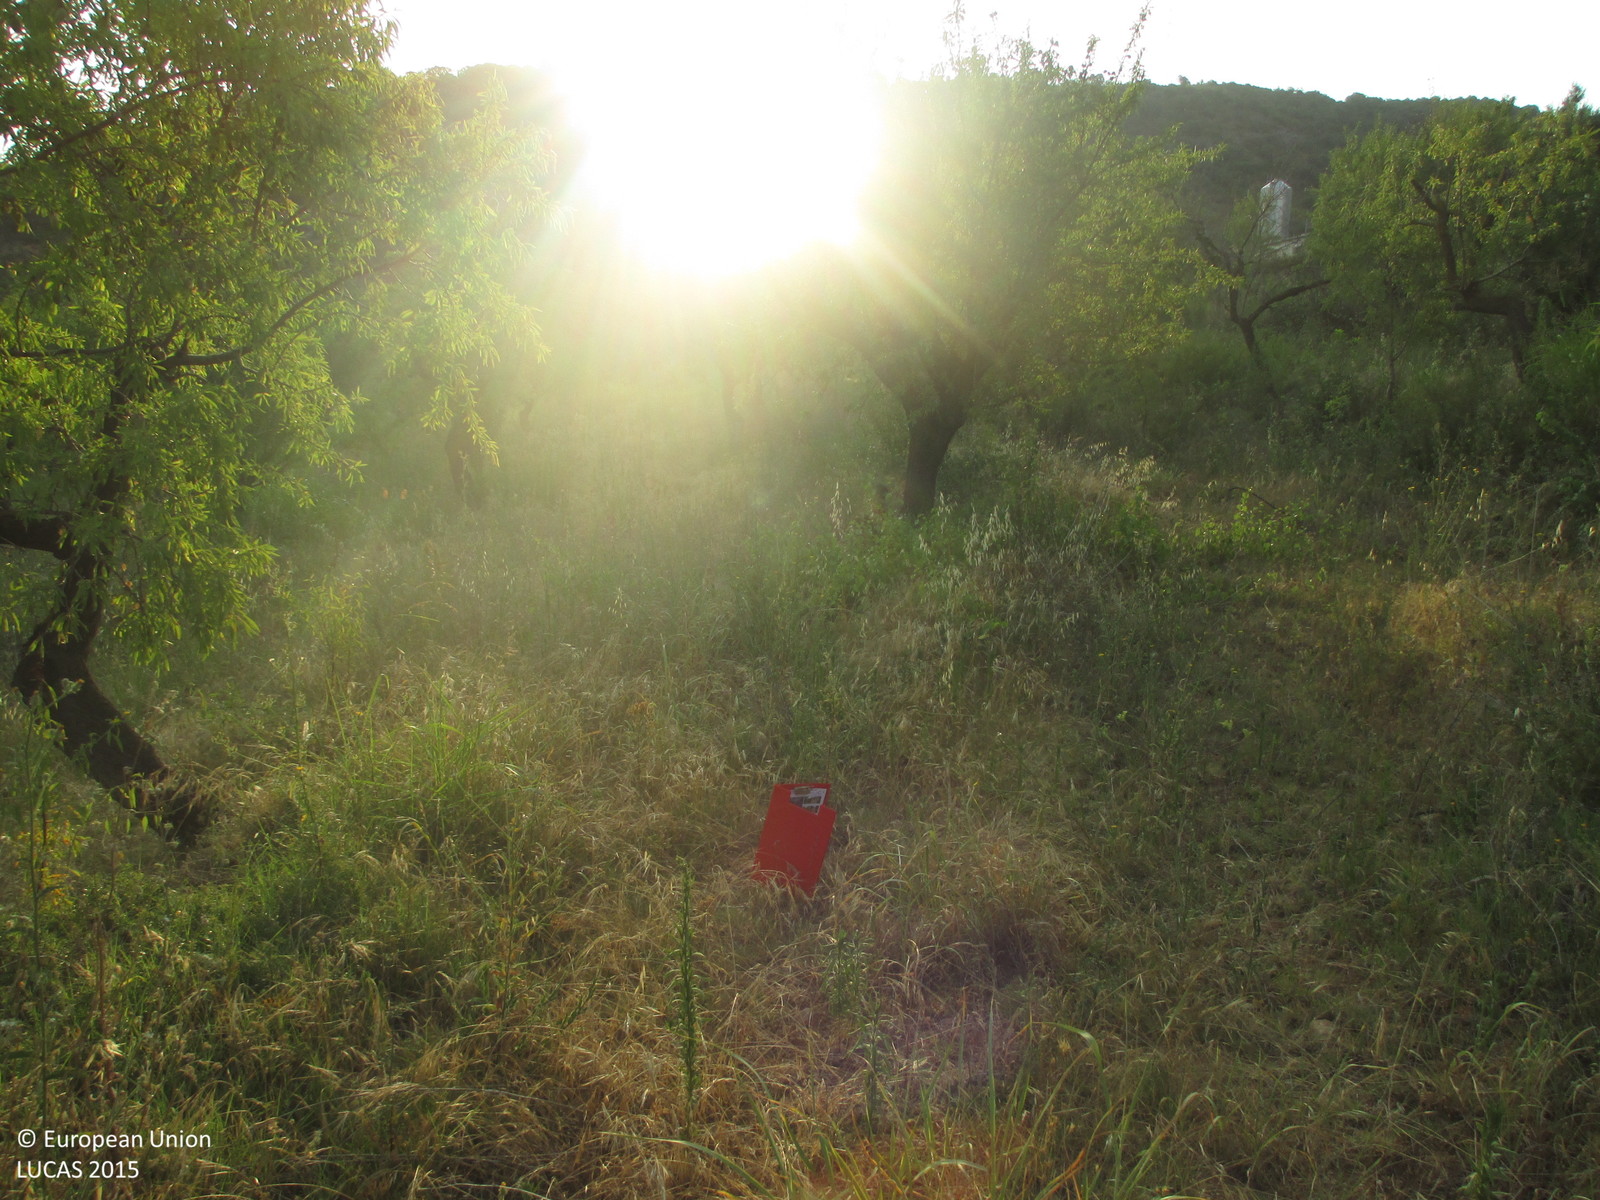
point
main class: Cropland
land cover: Nuts trees
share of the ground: 50 - 75 %
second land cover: Spontaneously vegetated surfaces
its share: > 75 %
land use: Agriculture (excluding fallow land and kitchen gardens)
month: July
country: ES
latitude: 42.1095
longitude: 0.2465
